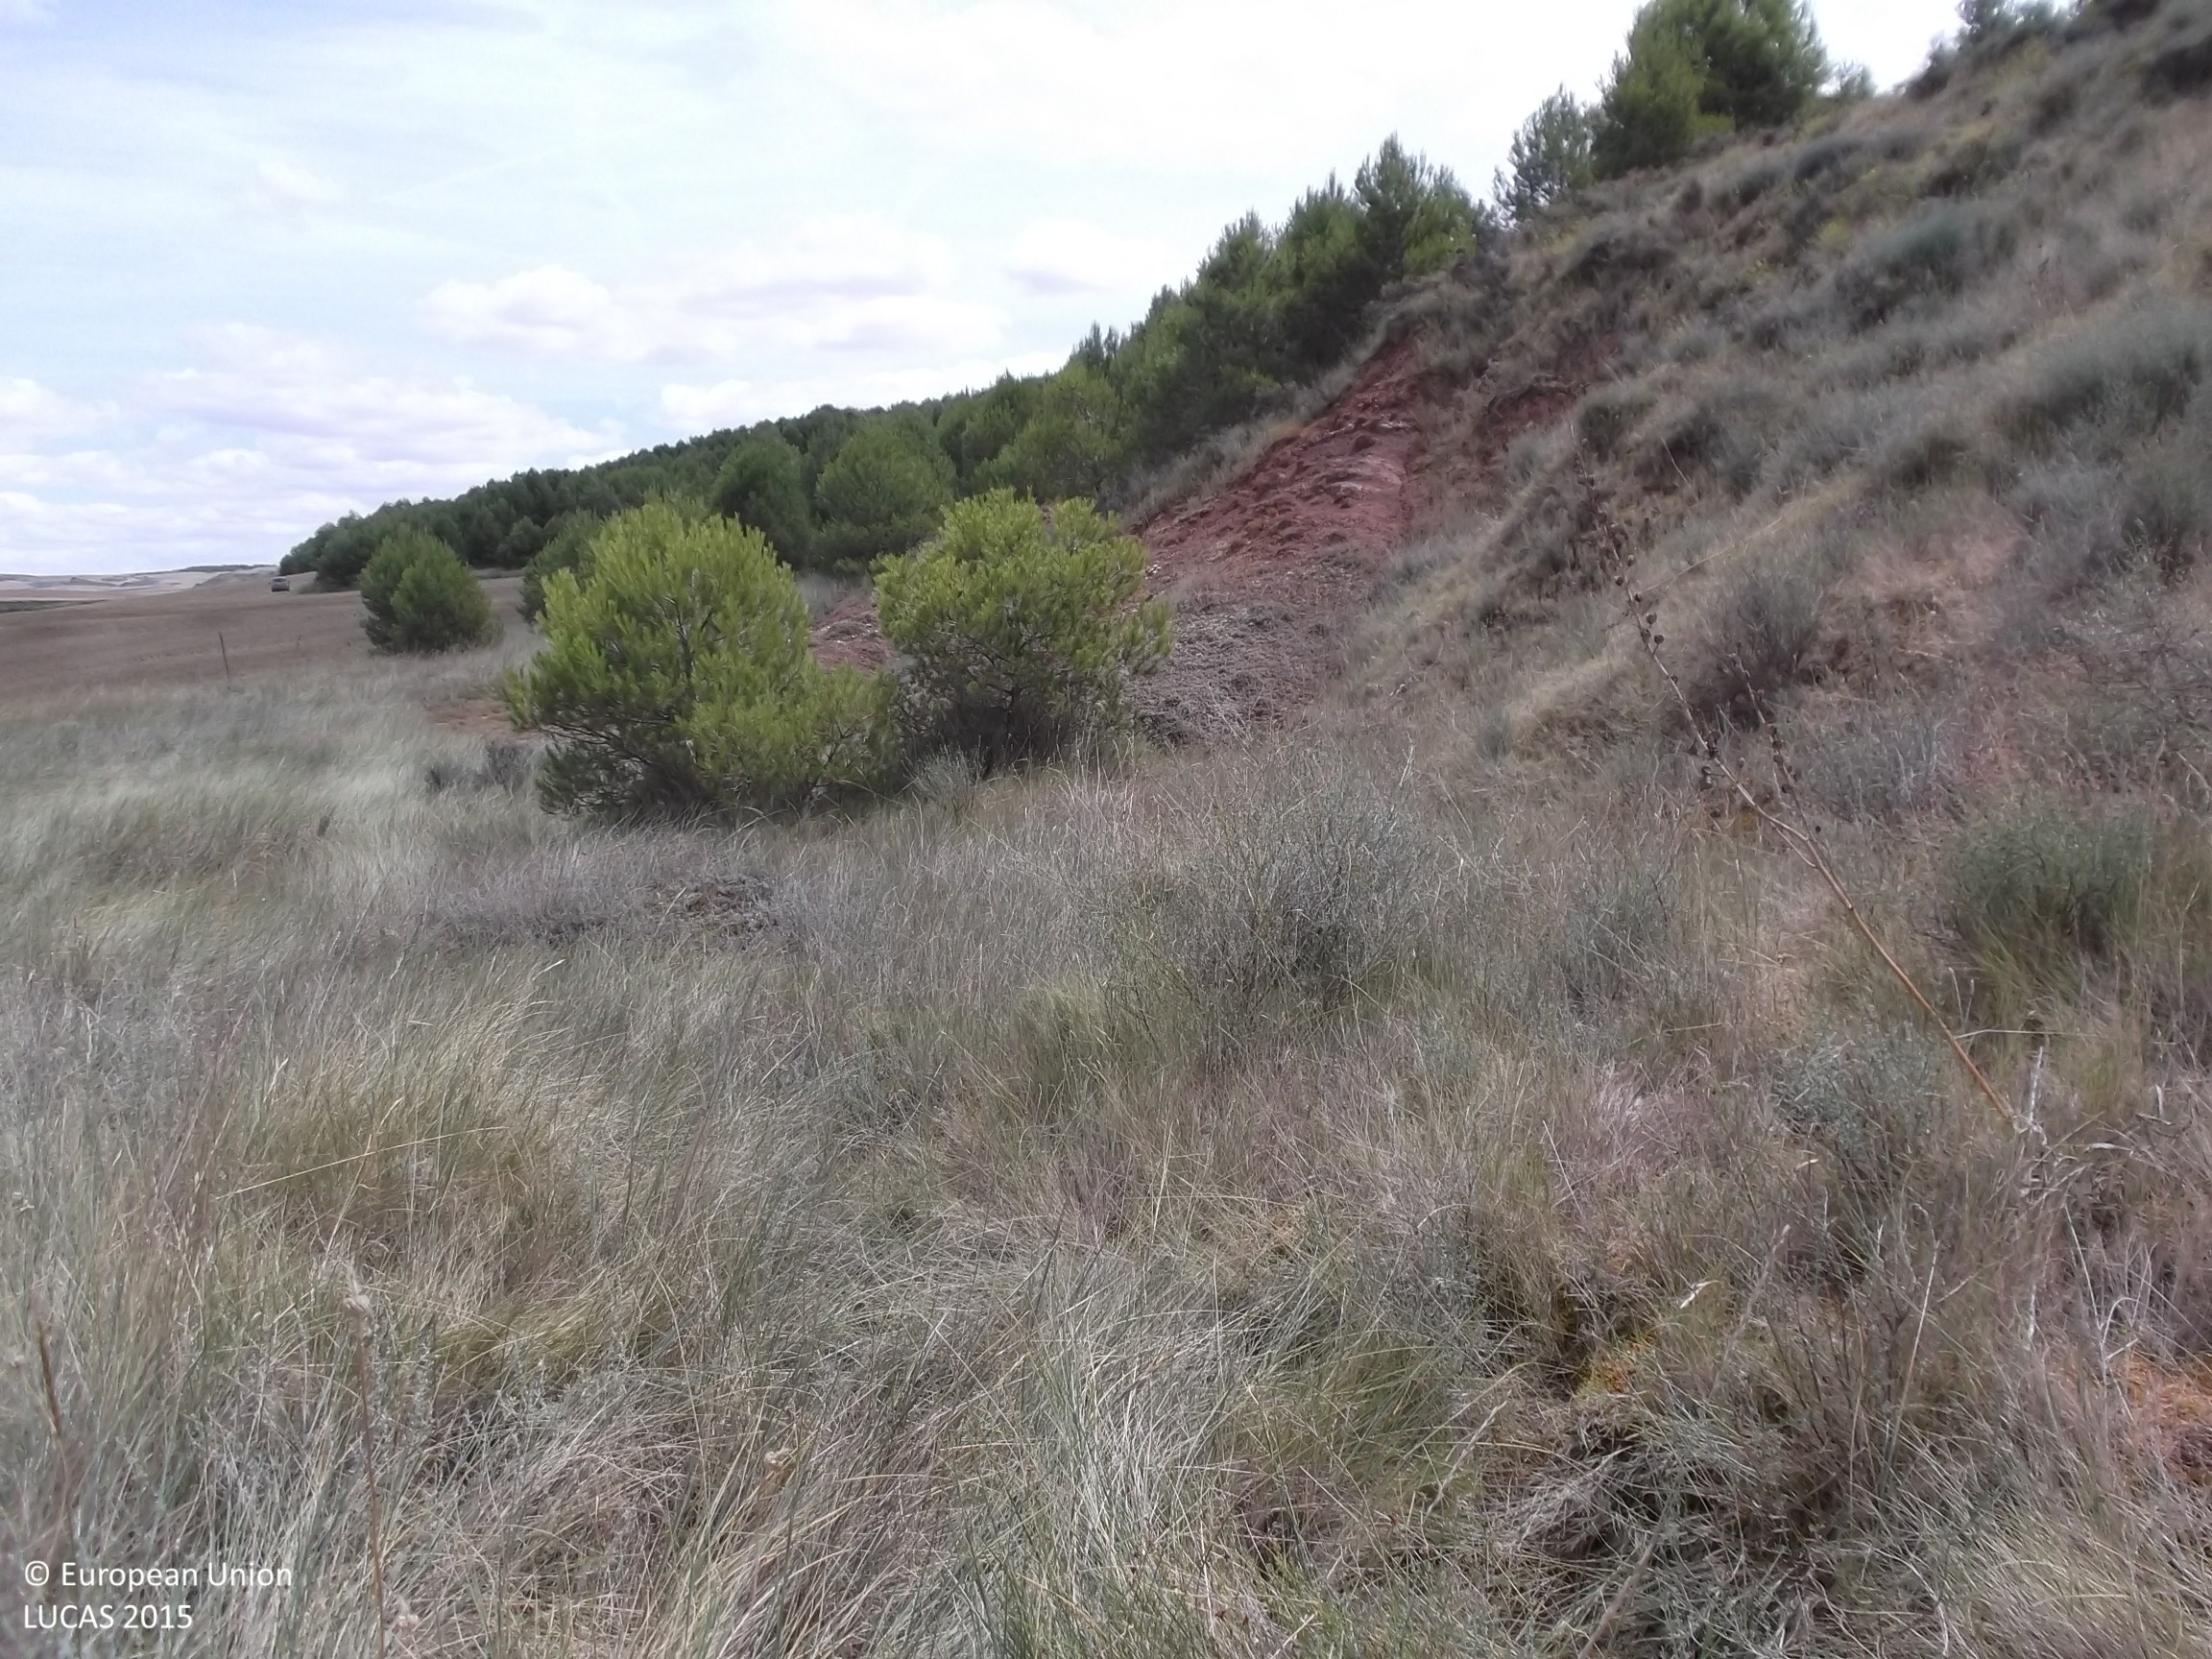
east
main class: Grassland
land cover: Grassland with sparse tree/shrub cover
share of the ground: > 75 %
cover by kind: herbaceous plants 70 %, lichens and mosses 10 %, unconsolidated bare surface 10 %, coniferous forest trees 5 %, shrubs 5 %
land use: Semi-natural and natural areas not in use
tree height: < 5 m
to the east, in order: Grassland with sparse tree/shrub cover; Pine dominated coniferous woodland; Grassland without tree/shrub cover; Common wheat
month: August
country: ES
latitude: 42.4827
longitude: -2.1704
